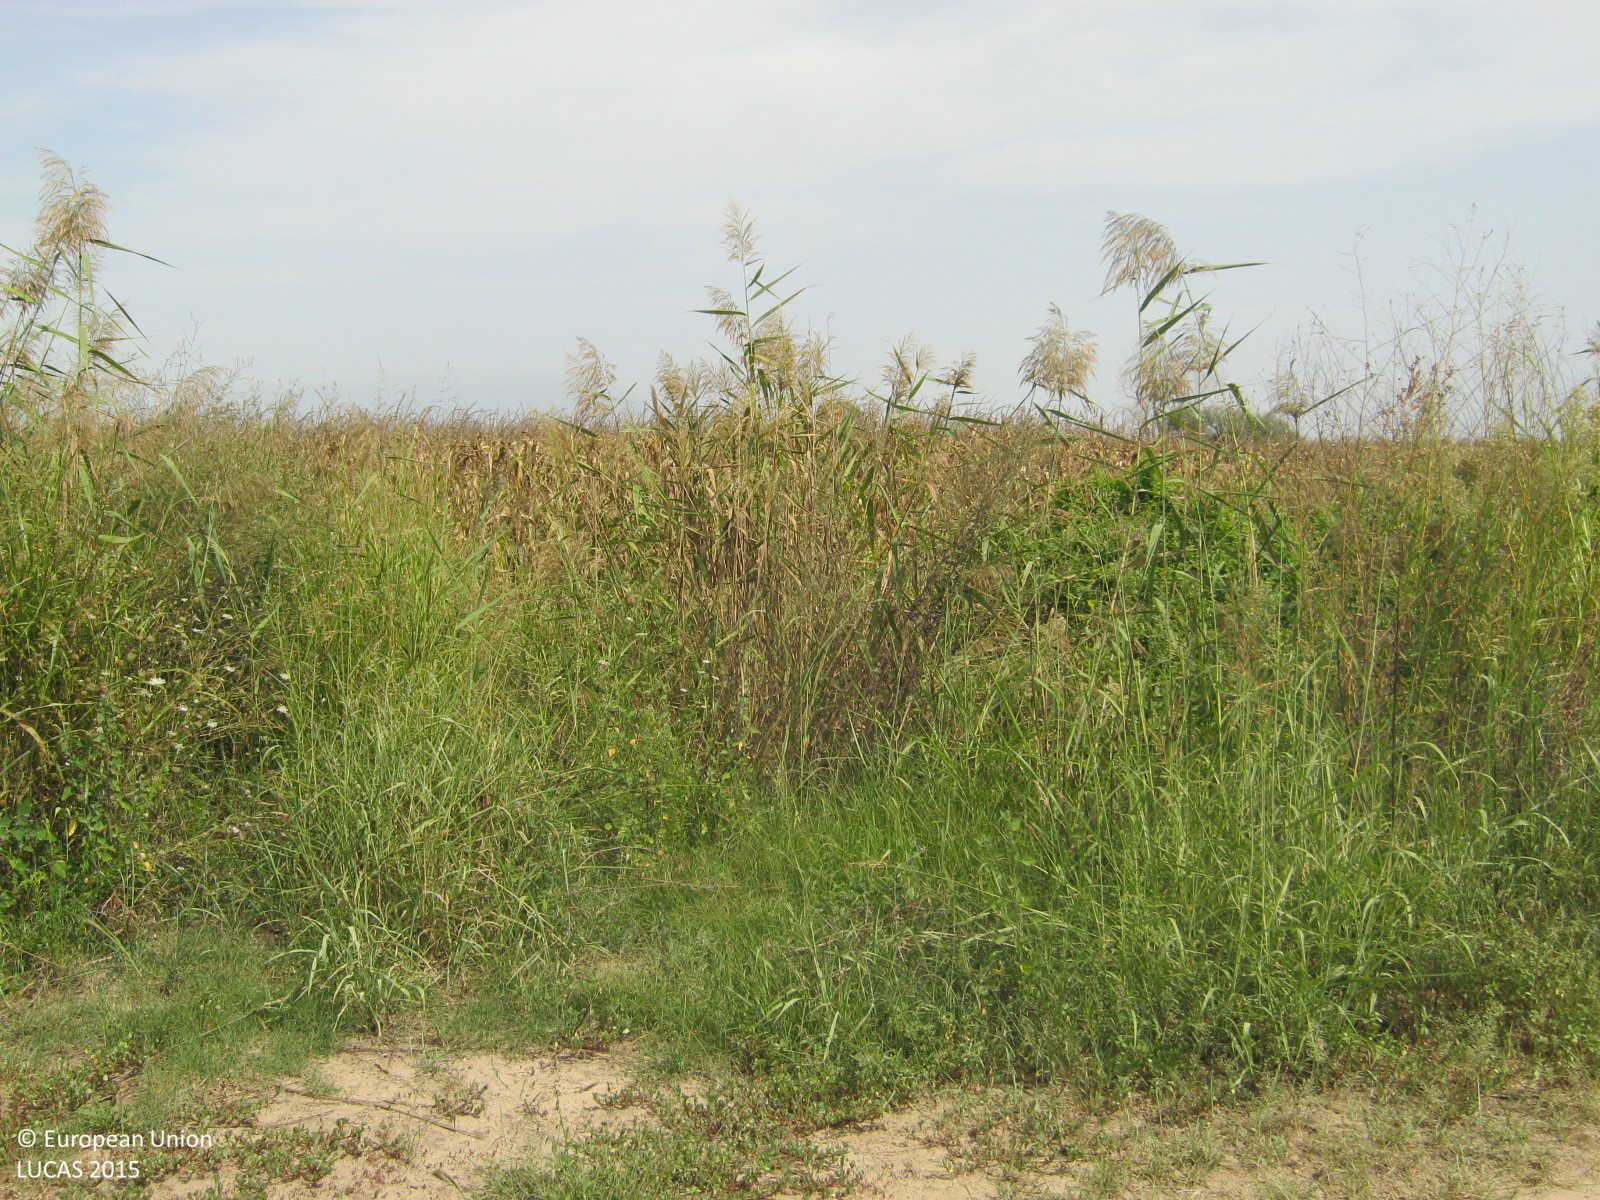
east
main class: Woodland
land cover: Broadleaved woodland
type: floodplain forest
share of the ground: 50 - 75 %
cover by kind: broadleaved forest trees 70 %, herbaceous plants 20 %, shrubs 10 %
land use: Forestry
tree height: < 5 m
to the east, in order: Broadleaved woodland; Inland marshes; Tracks; Ditches and canals; Abandoned hedges; Maize
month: September
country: GR
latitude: 41.0971
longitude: 23.2919
